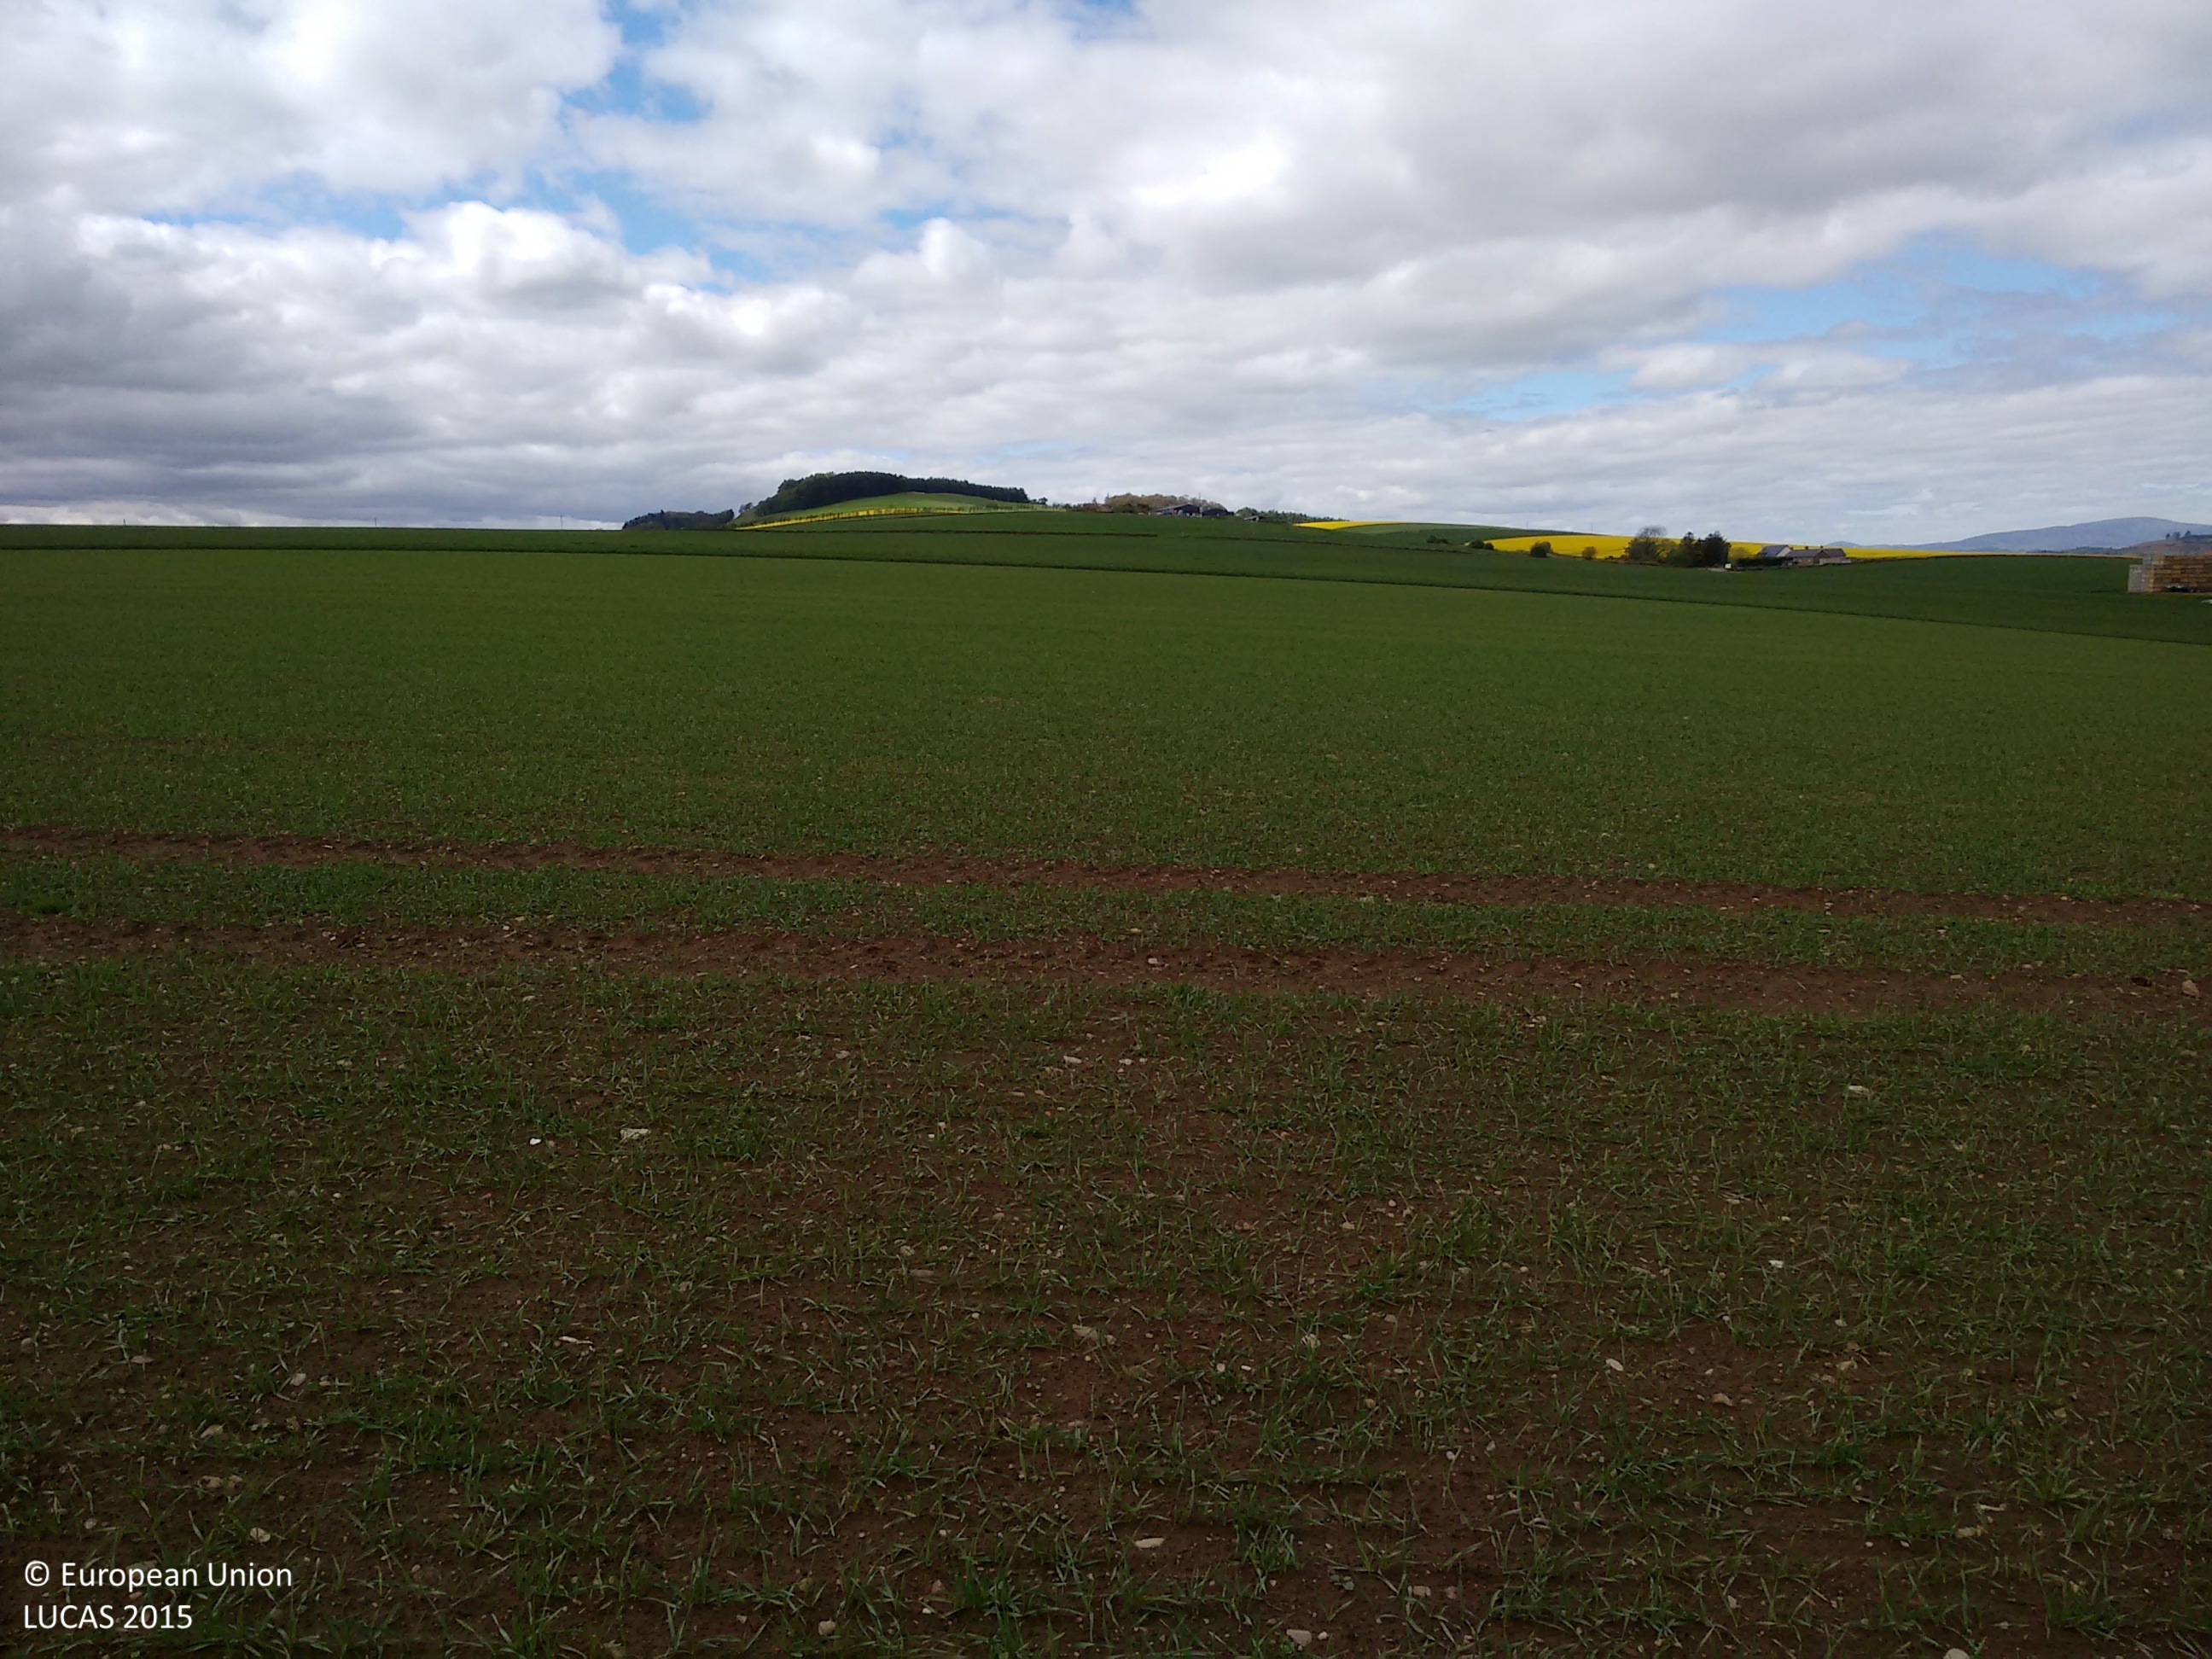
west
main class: Cropland
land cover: Barley
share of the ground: 25 - 50 %
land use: Agriculture (excluding fallow land and kitchen gardens)
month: May
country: GB
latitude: 56.6410
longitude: -2.7634
